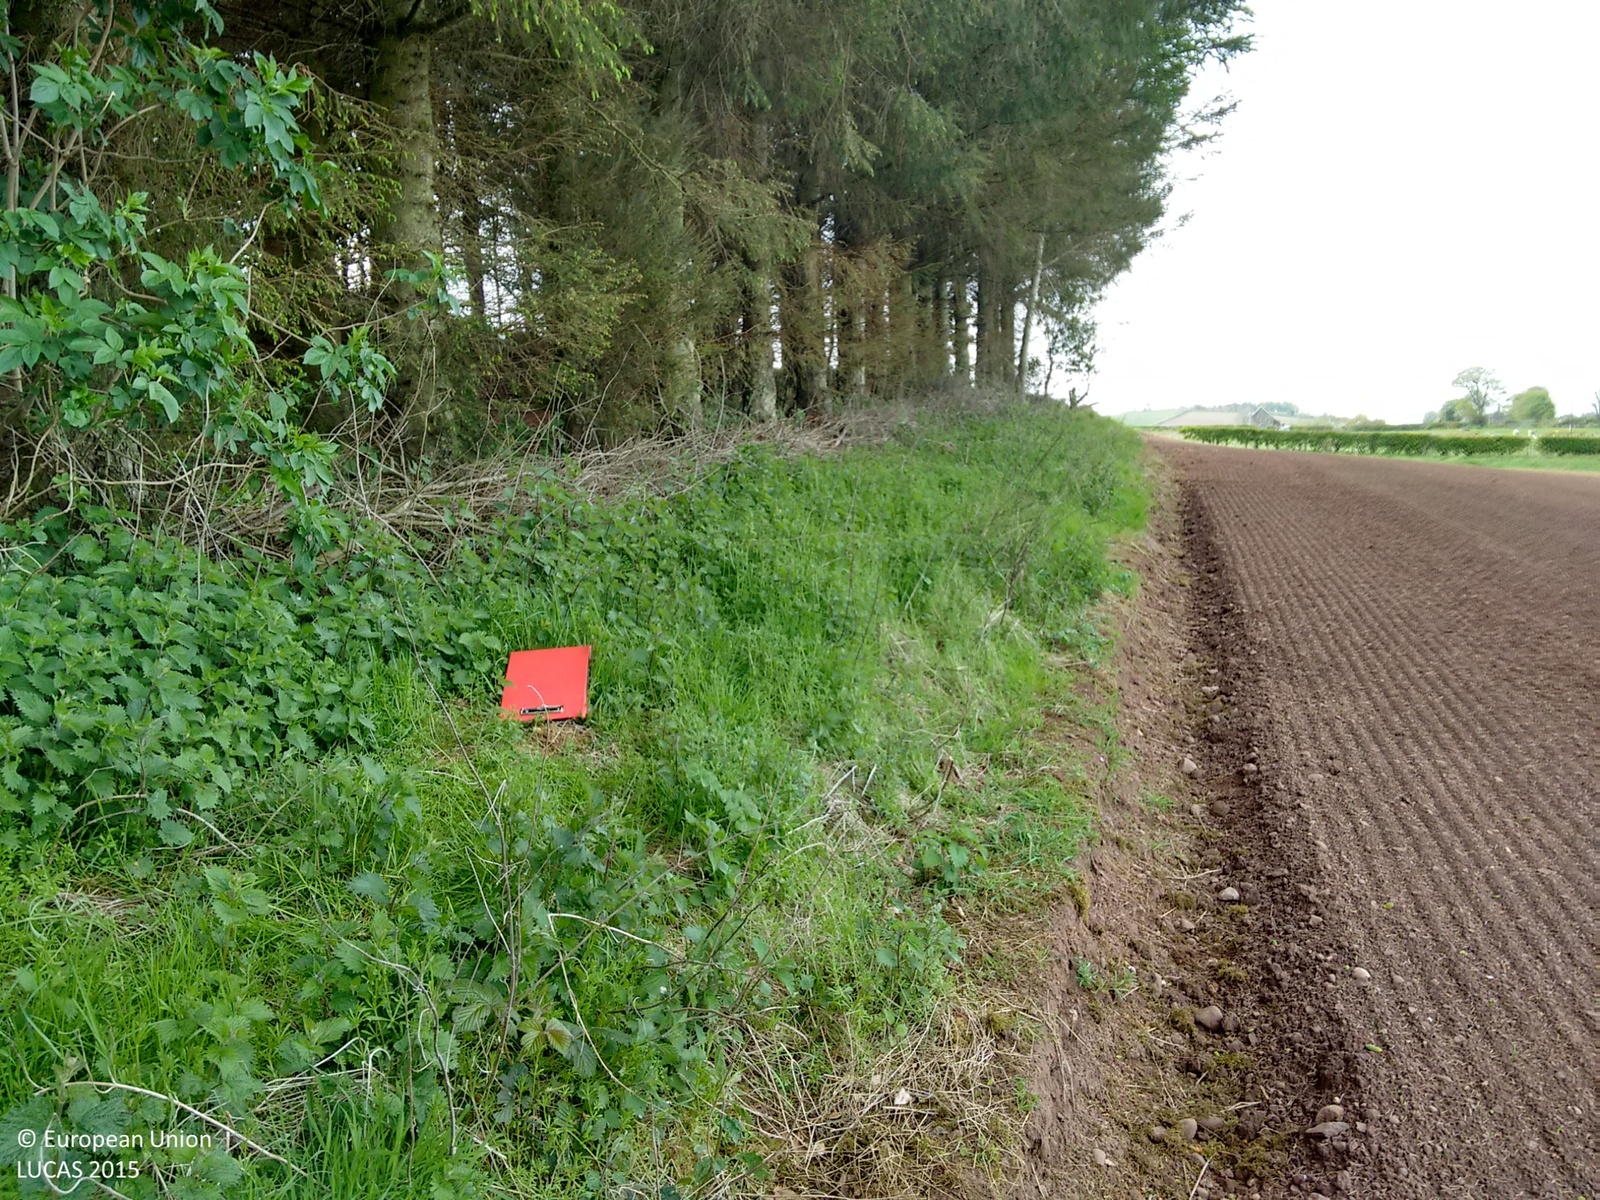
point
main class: Cropland
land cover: Dry pulses
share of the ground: < 10 %
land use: Agriculture (excluding fallow land and kitchen gardens)
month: May
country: GB
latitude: 55.7914
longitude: -2.3218
